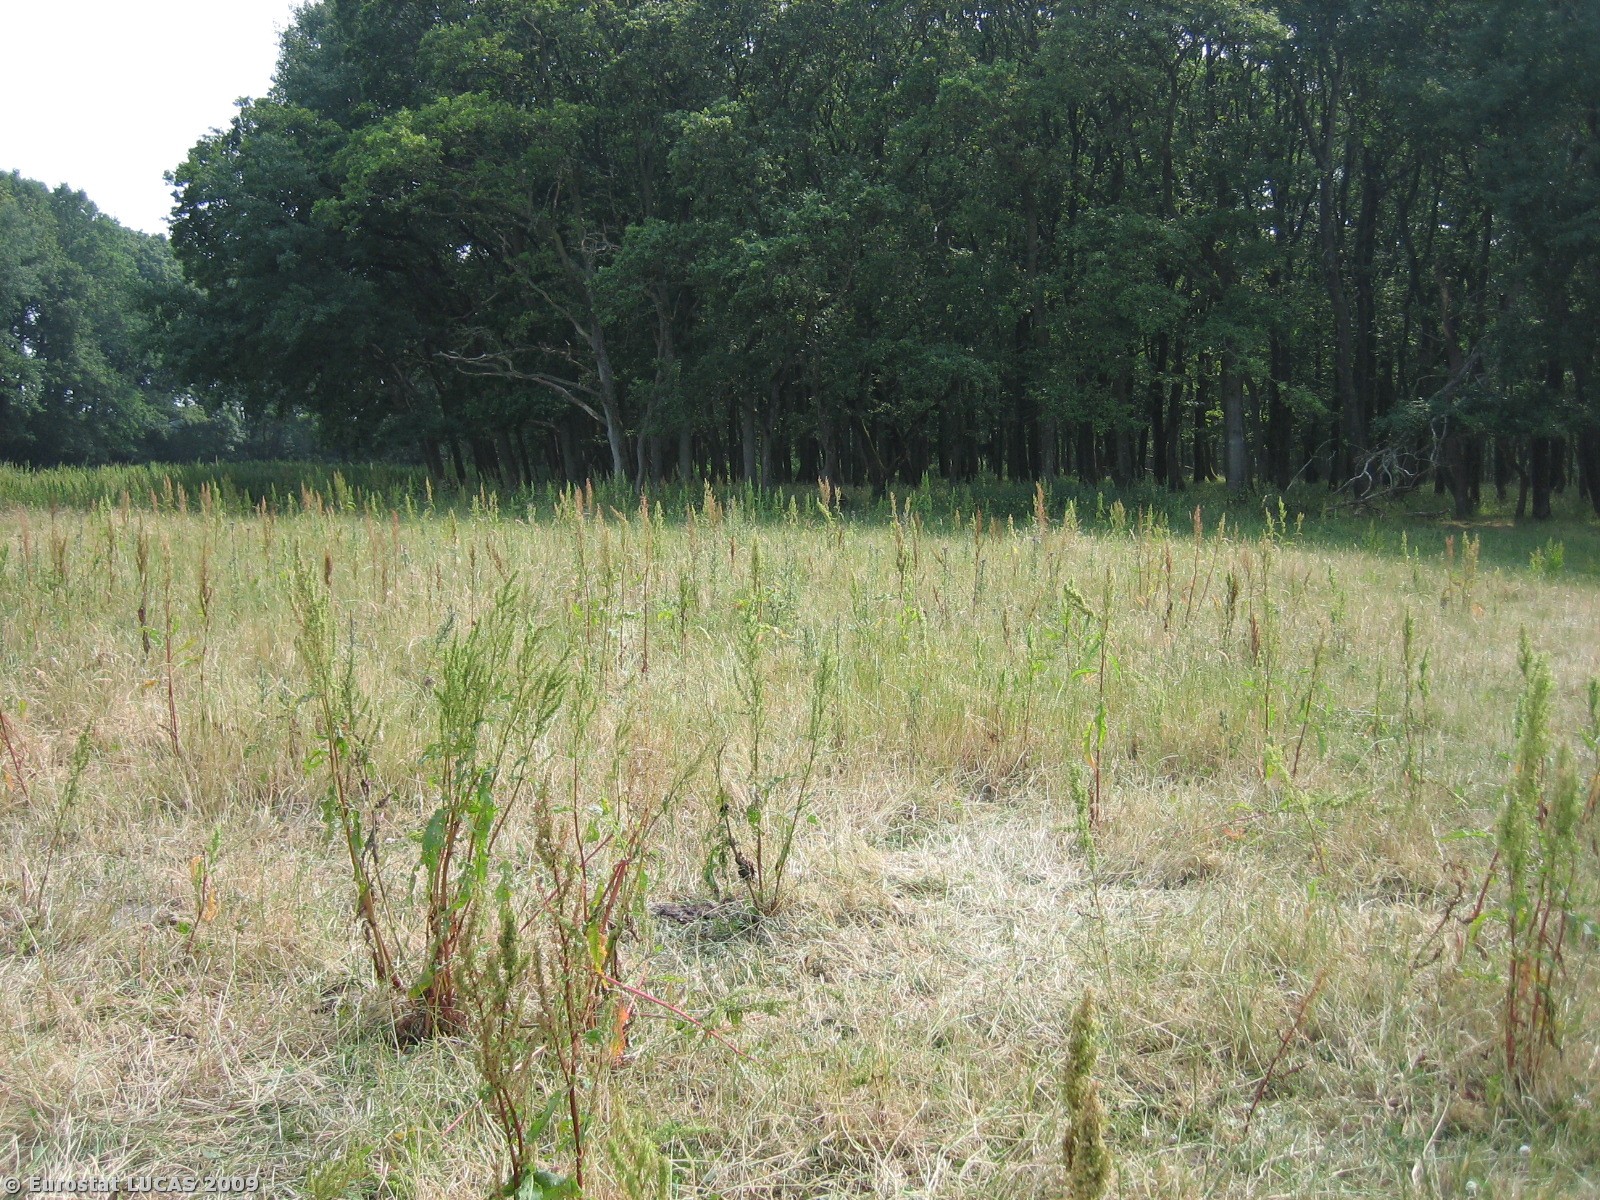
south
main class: Grassland
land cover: Grassland without tree/shrub cover
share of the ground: > 75 %
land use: Agriculture (excluding fallow land and kitchen gardens)
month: July
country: DK
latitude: 55.5710
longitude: 8.8117
